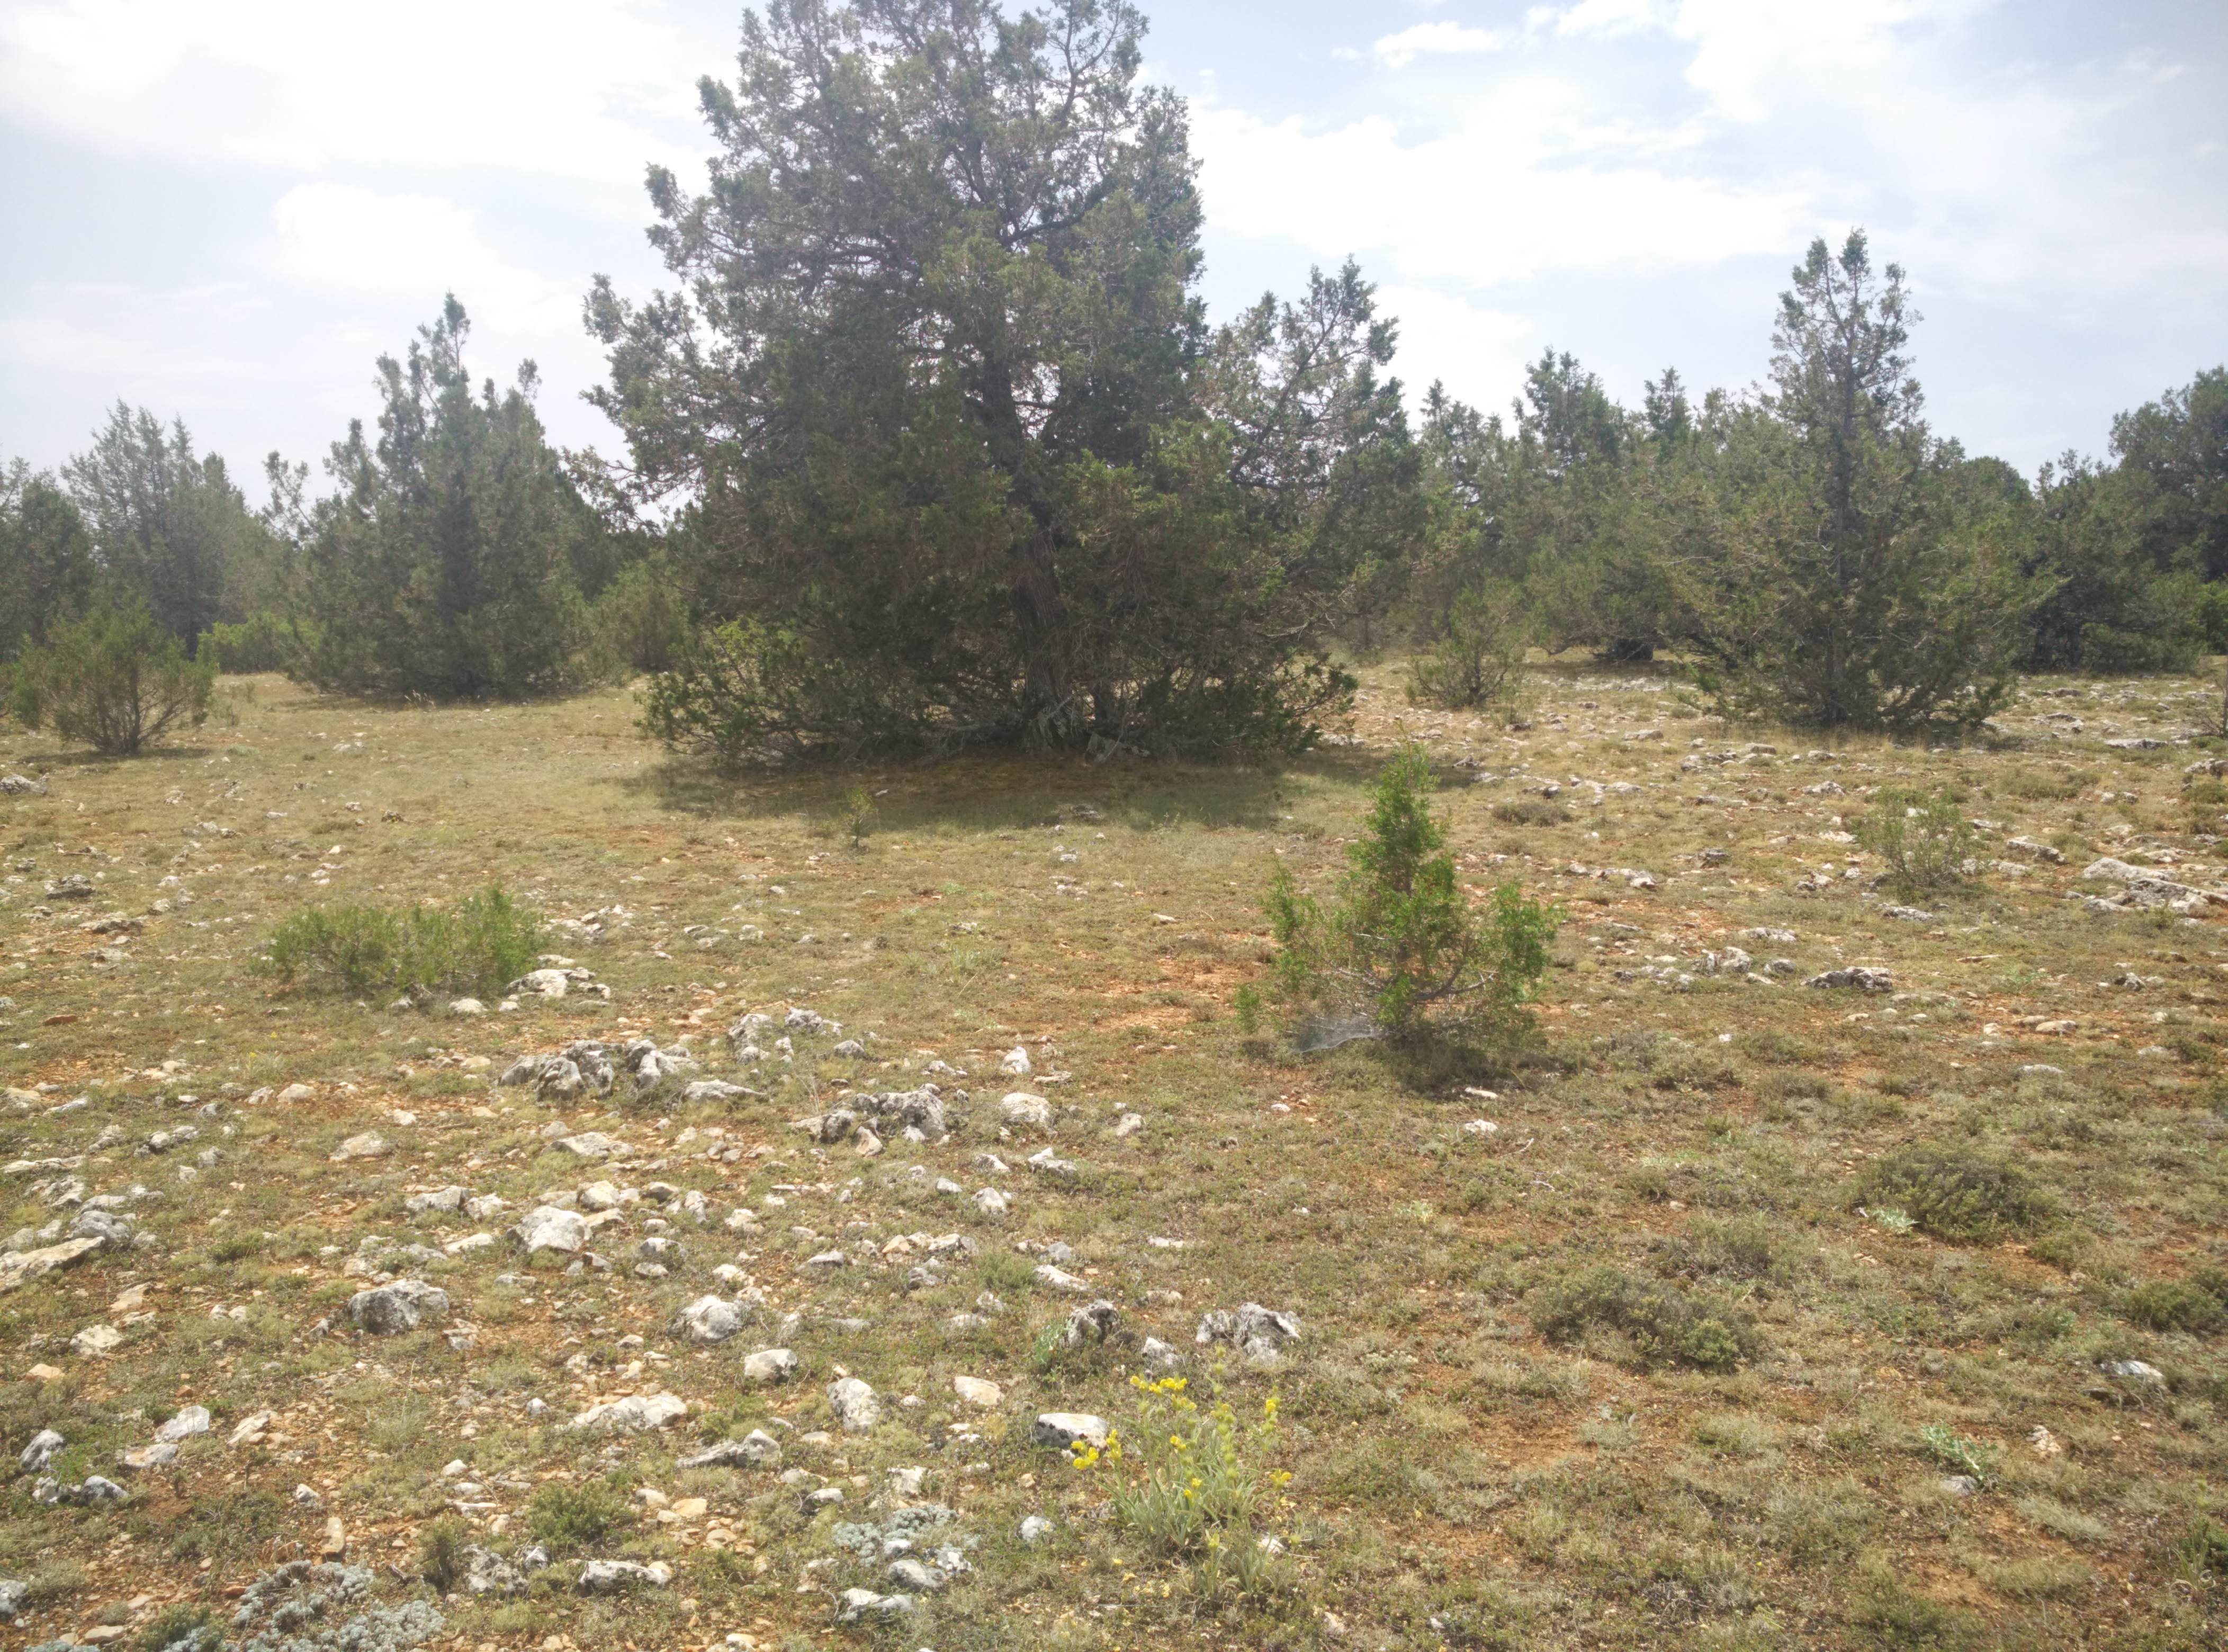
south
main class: Woodland
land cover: Other coniferous woodland
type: coniferous forest of the mediterranean region
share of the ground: 10 - 25 %
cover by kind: unconsolidated bare surface 55 %, shrubs 20 %, coniferous forest trees 15 %, herbaceous plants 5 %, lichens and mosses 5 %
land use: Semi-natural and natural areas not in use
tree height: > 5 m
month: July
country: ES
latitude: 40.8948
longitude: -2.0242
